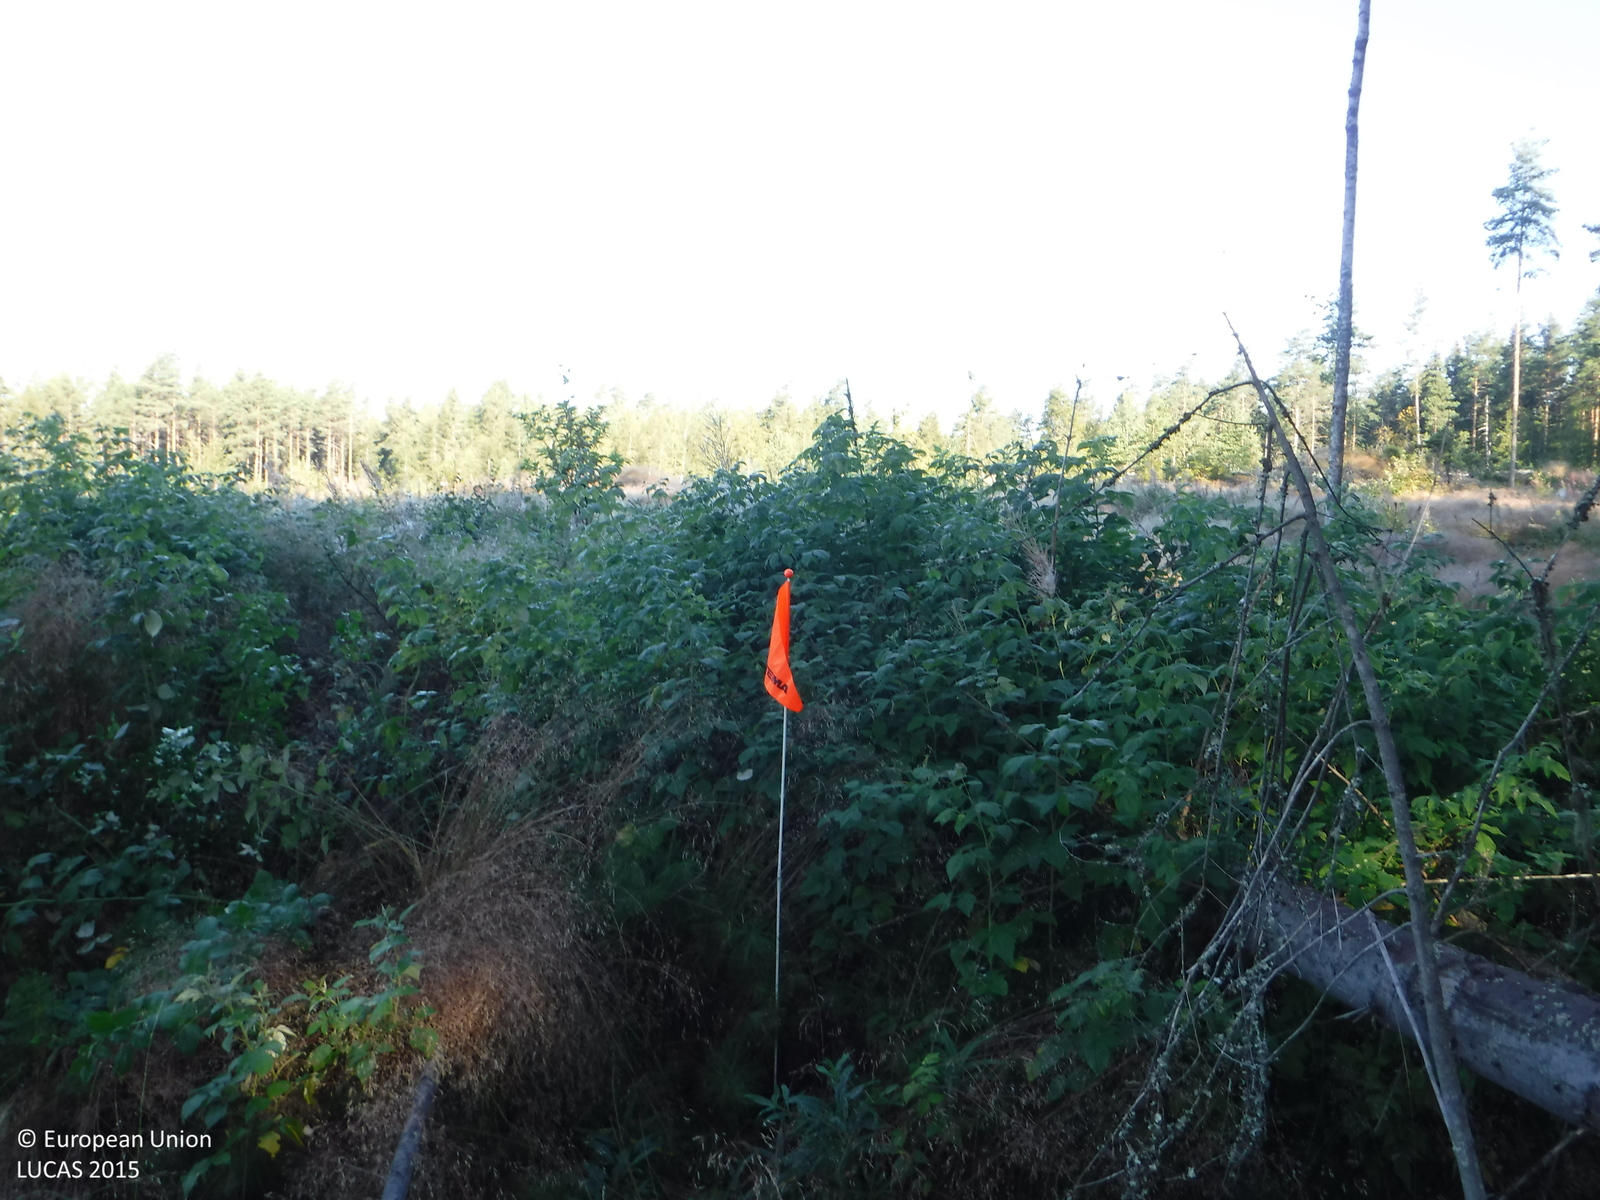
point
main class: Shrubland
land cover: Shrubland with sparse tree cover
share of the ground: 25 - 50 %
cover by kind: shrubs 40 %, herbaceous plants 40 %, broadleaved forest trees 5 %
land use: Forestry
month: August
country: FI
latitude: 61.1002
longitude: 21.6481
